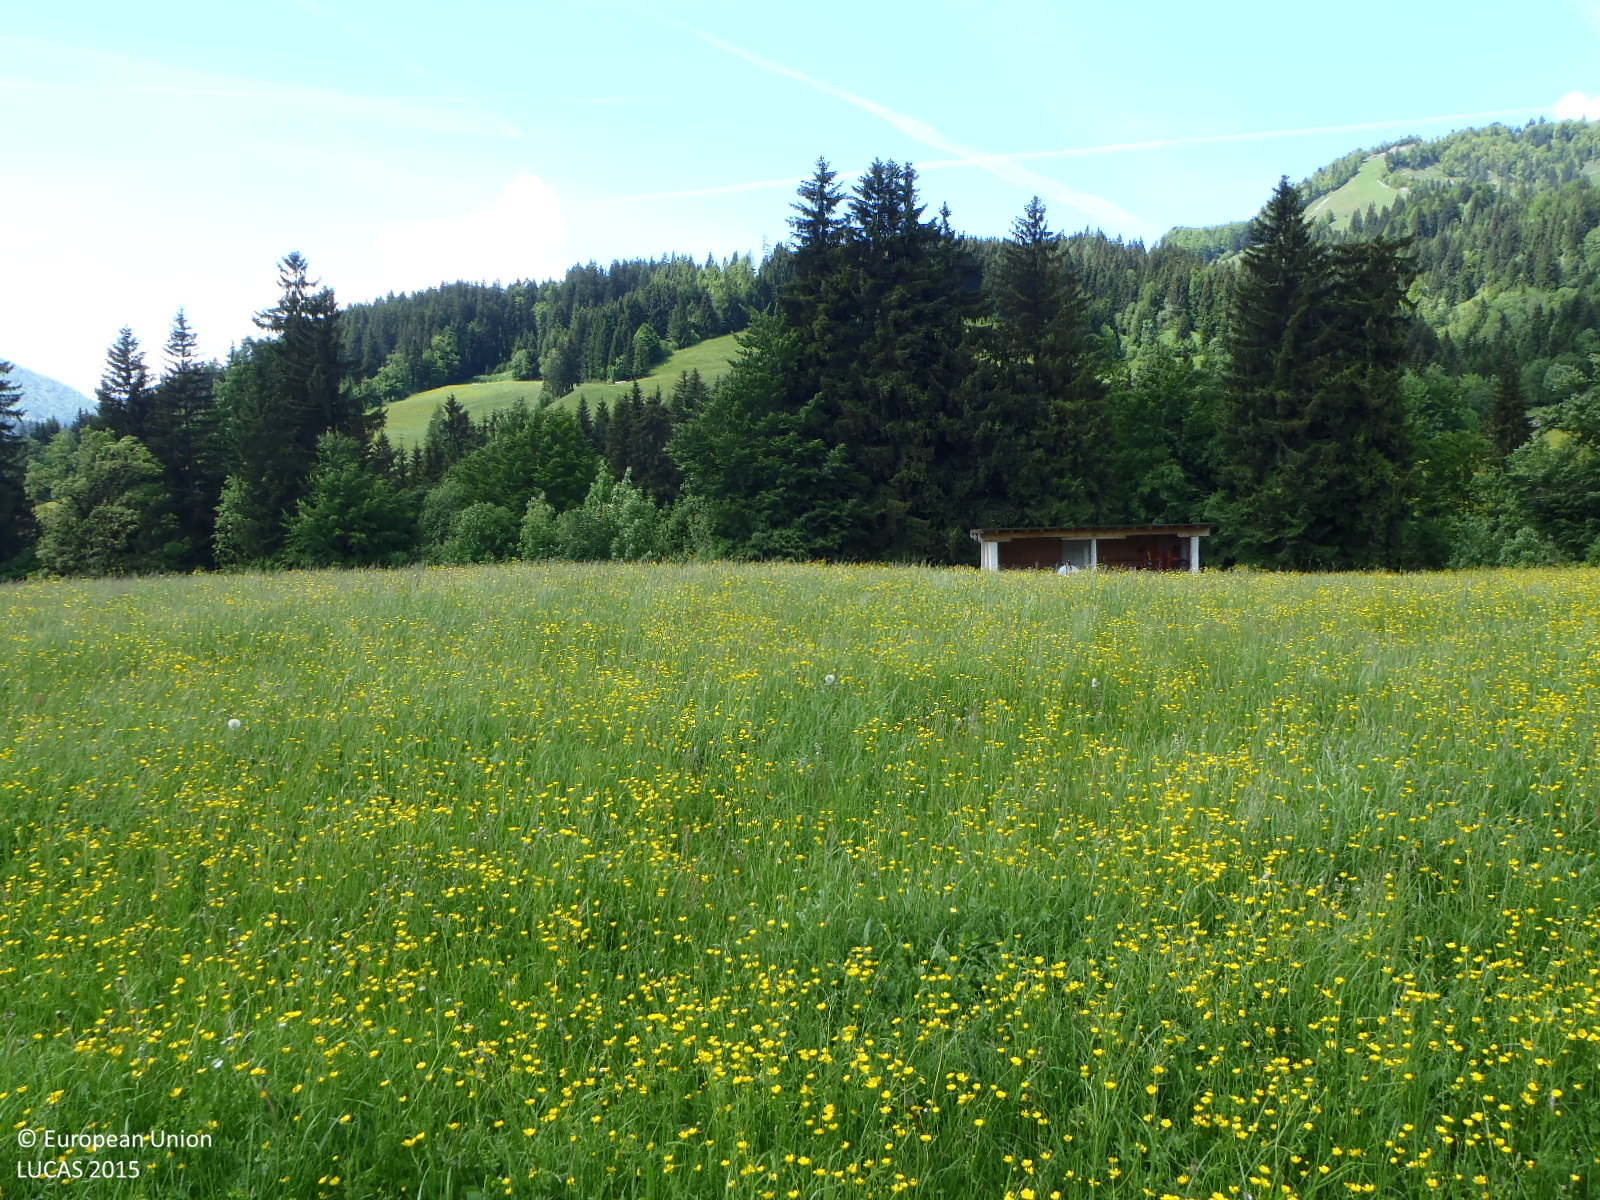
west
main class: Grassland
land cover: Grassland without tree/shrub cover
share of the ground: > 75 %
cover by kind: herbaceous plants 100 %
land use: Agriculture (excluding fallow land and kitchen gardens)
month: June
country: AT
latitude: 47.4723
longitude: 12.6121
